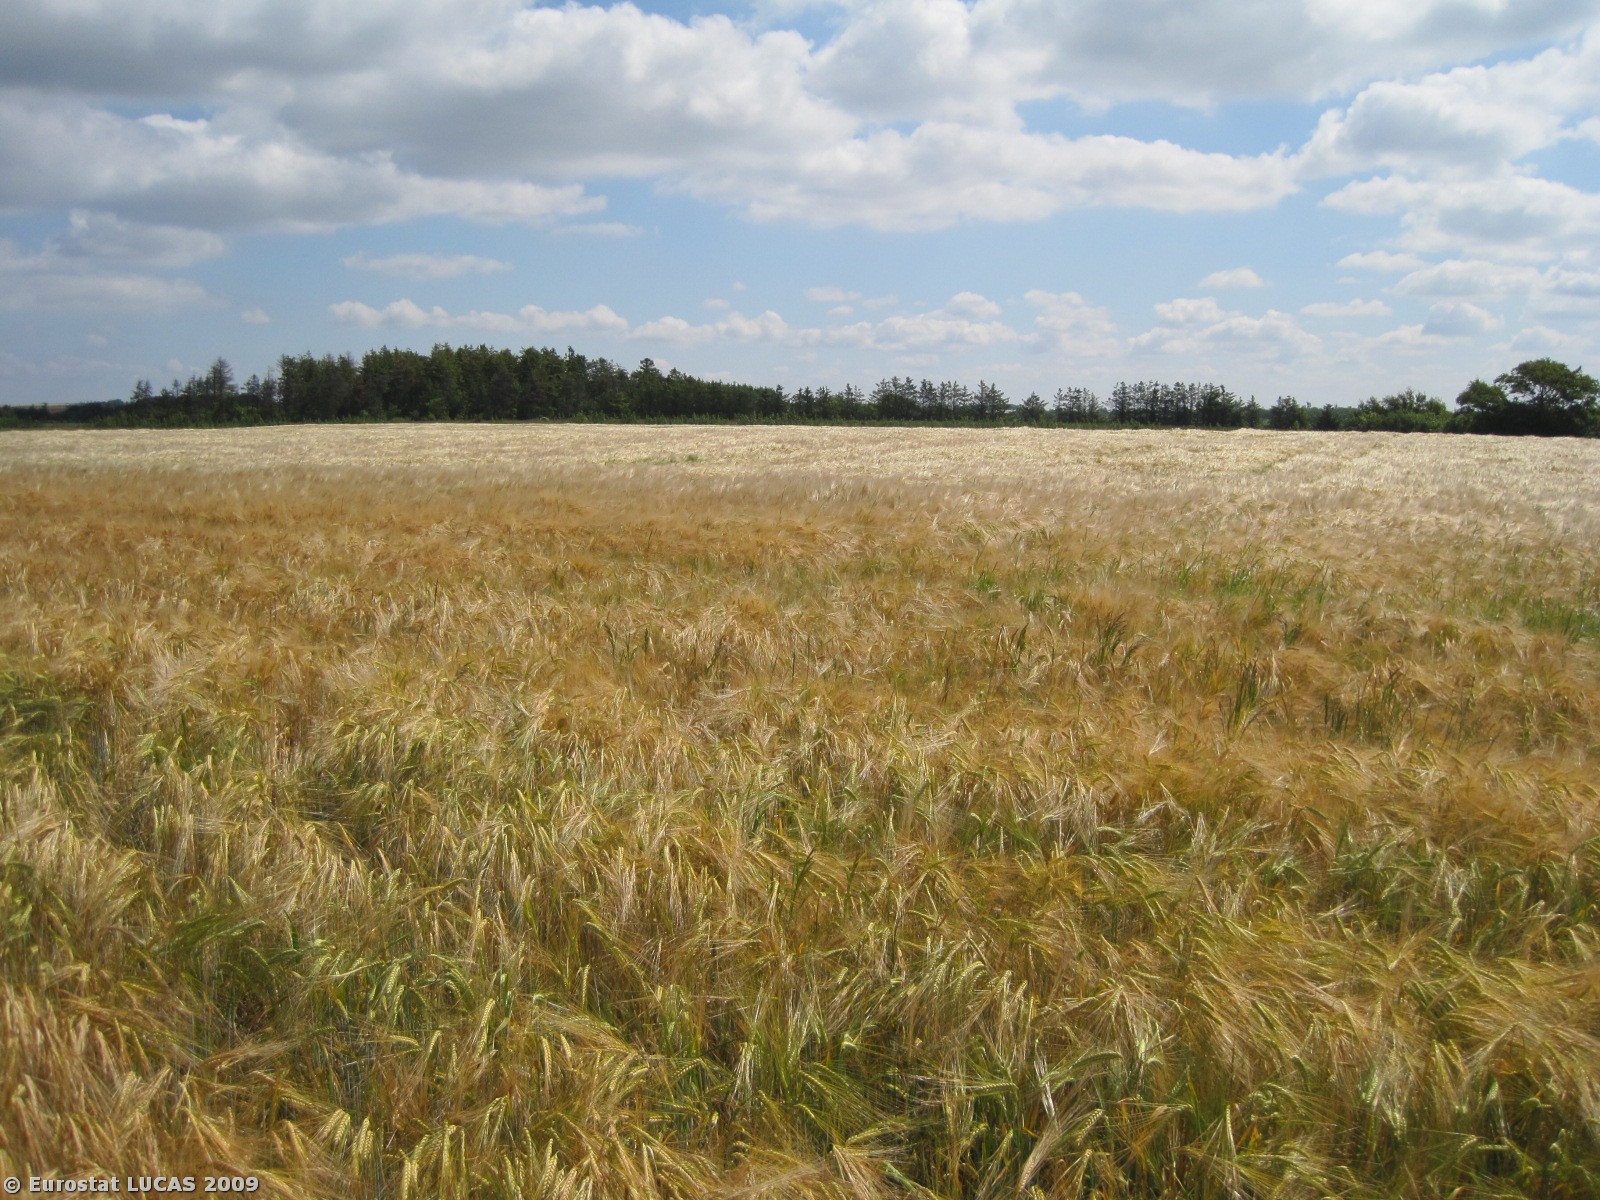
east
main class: Cropland
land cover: Barley
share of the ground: > 75 %
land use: Agriculture (excluding fallow land and kitchen gardens)
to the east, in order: Barley; Grass margins; Tracks; Grass margins; Broadleaved woodland; Grassland without tree/shrub cover
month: June
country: DK
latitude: 56.5609
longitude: 8.9437
